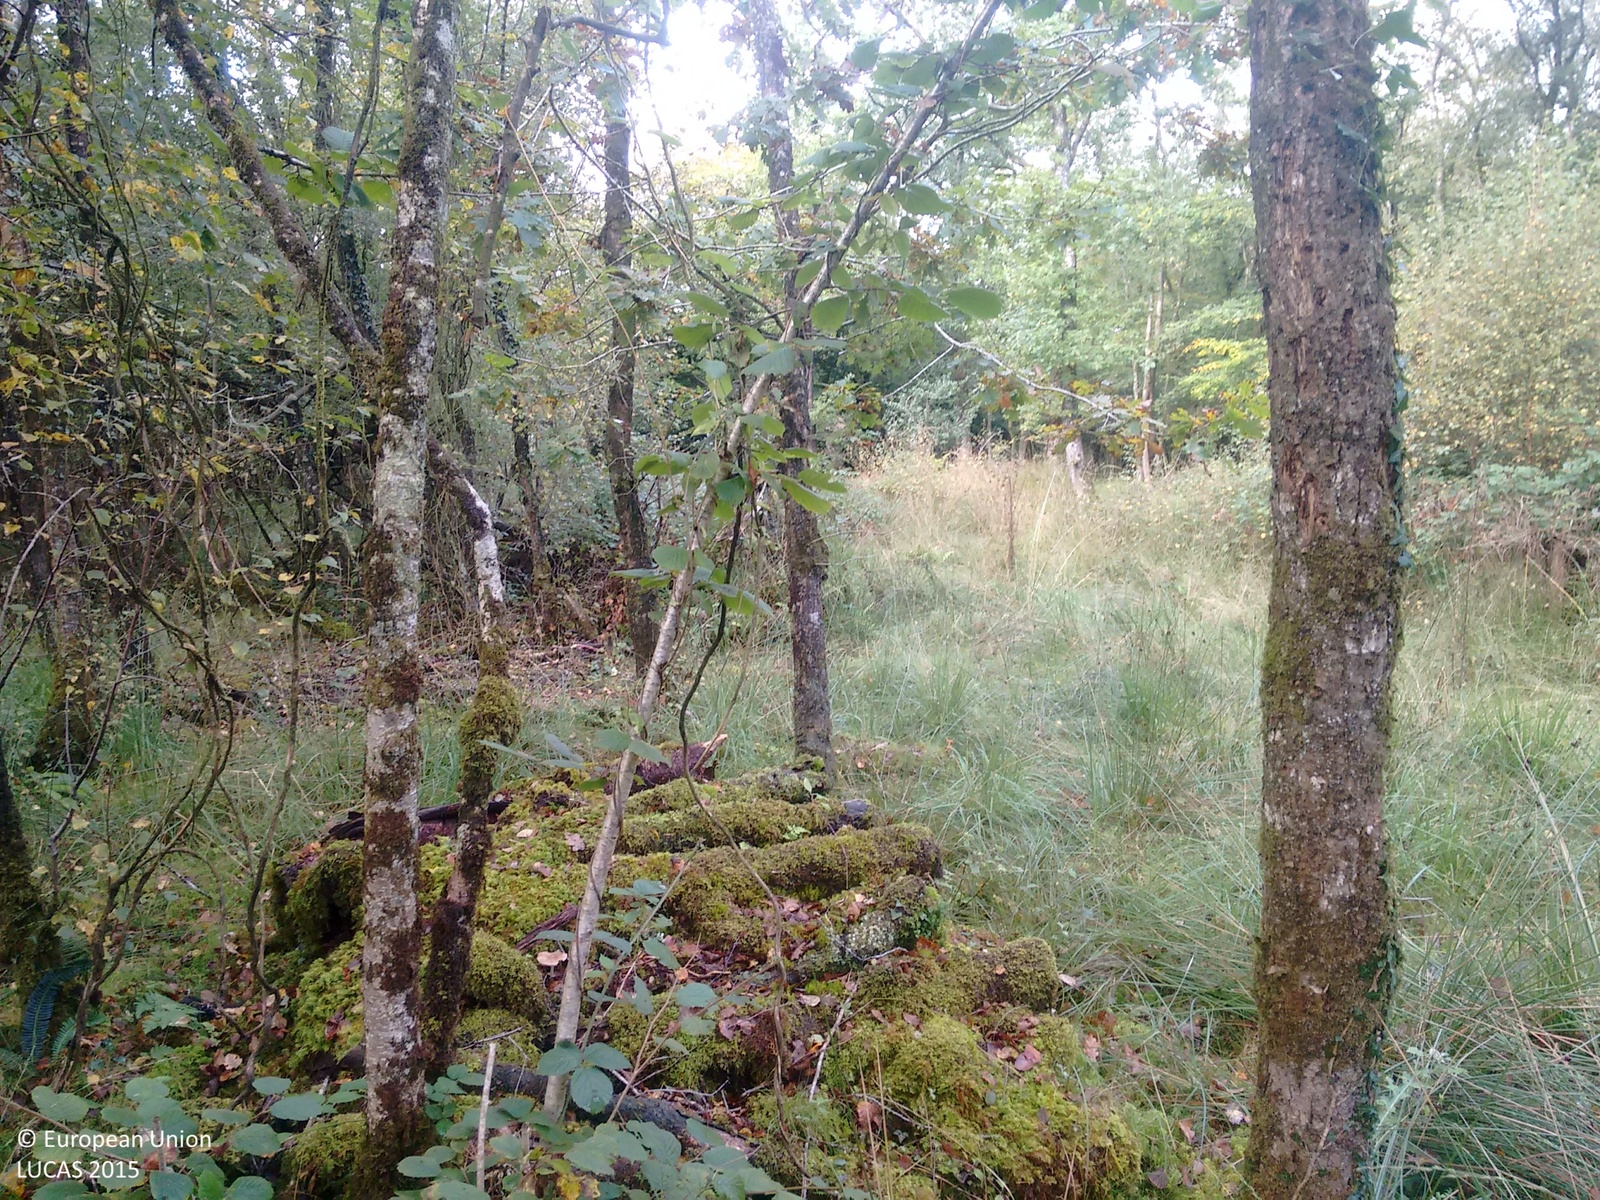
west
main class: Woodland
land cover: Broadleaved woodland
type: acidophilous oak and oak-birch forest
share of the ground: > 75 %
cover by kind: broadleaved forest trees 100 %
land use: Forestry
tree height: > 5 m
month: September
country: GB
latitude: 50.7612
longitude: -4.2622
